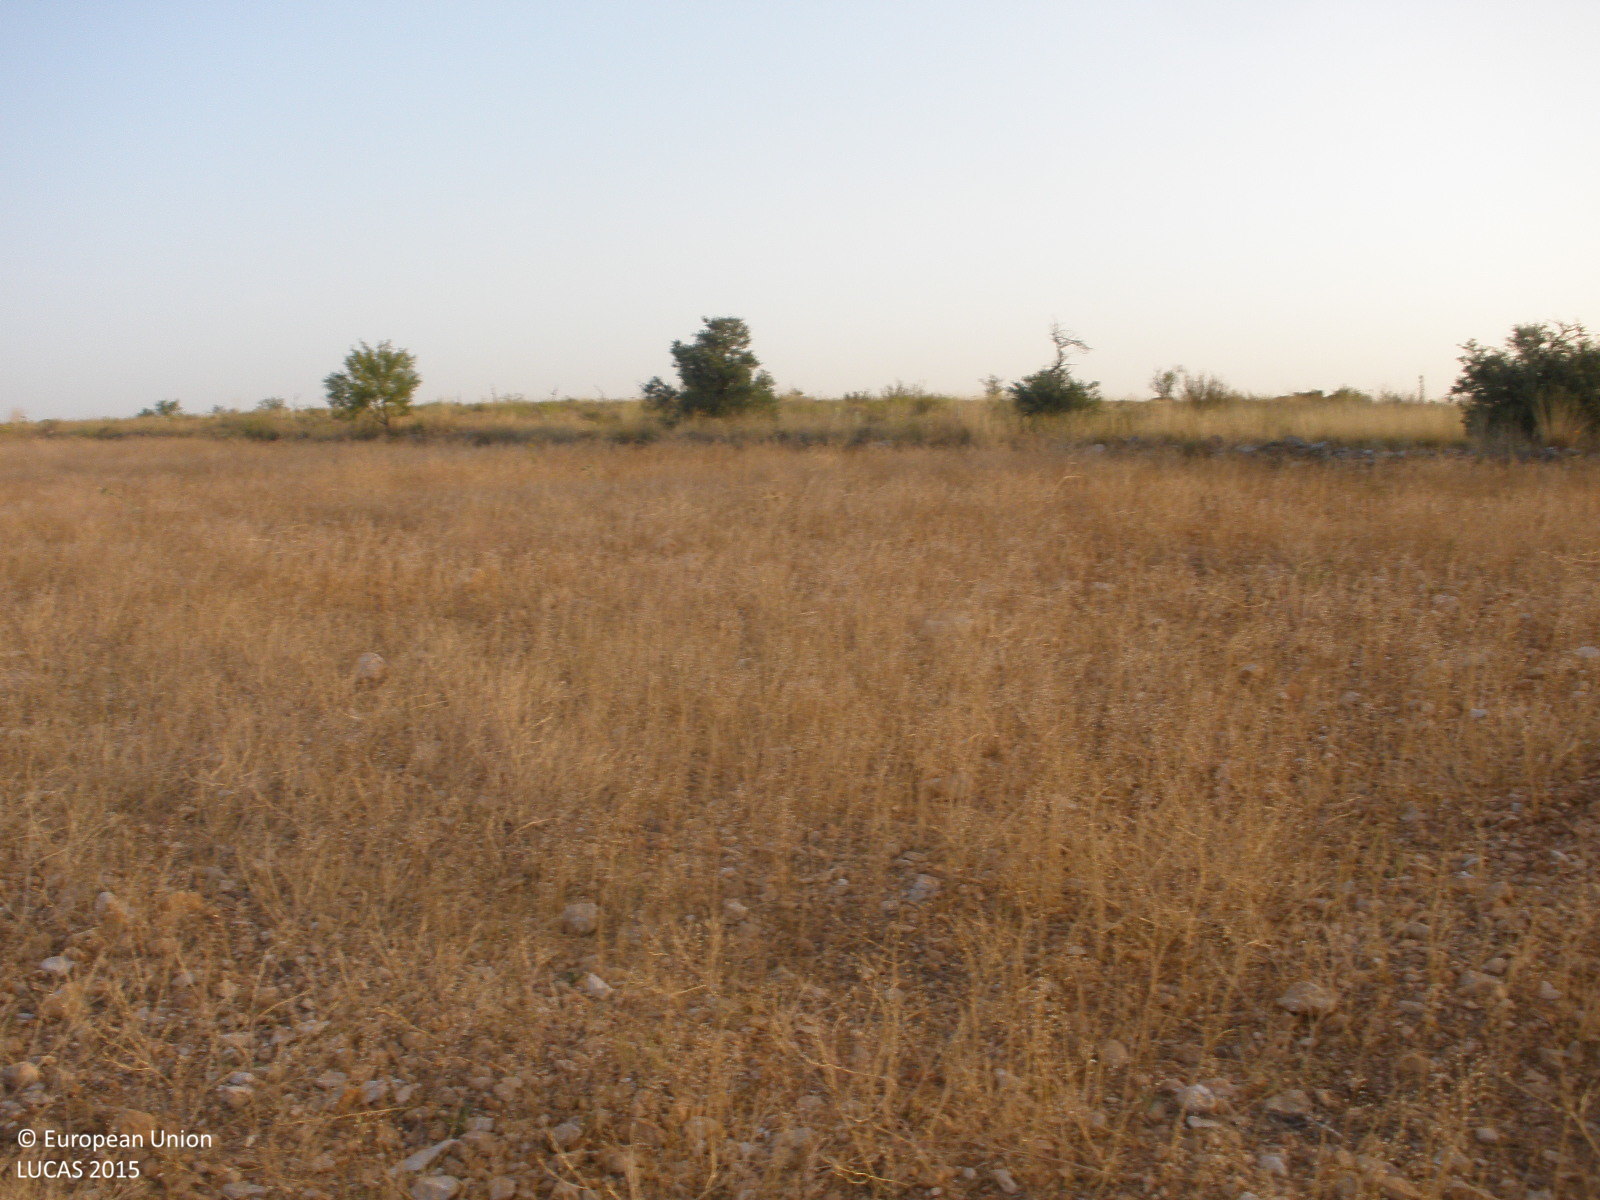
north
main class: Grassland
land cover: Spontaneously vegetated surfaces
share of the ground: > 75 %
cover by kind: herbaceous plants 80 %, unconsolidated bare surface 20 %
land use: Fallow land
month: July
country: ES
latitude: 40.1523
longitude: -3.3776
